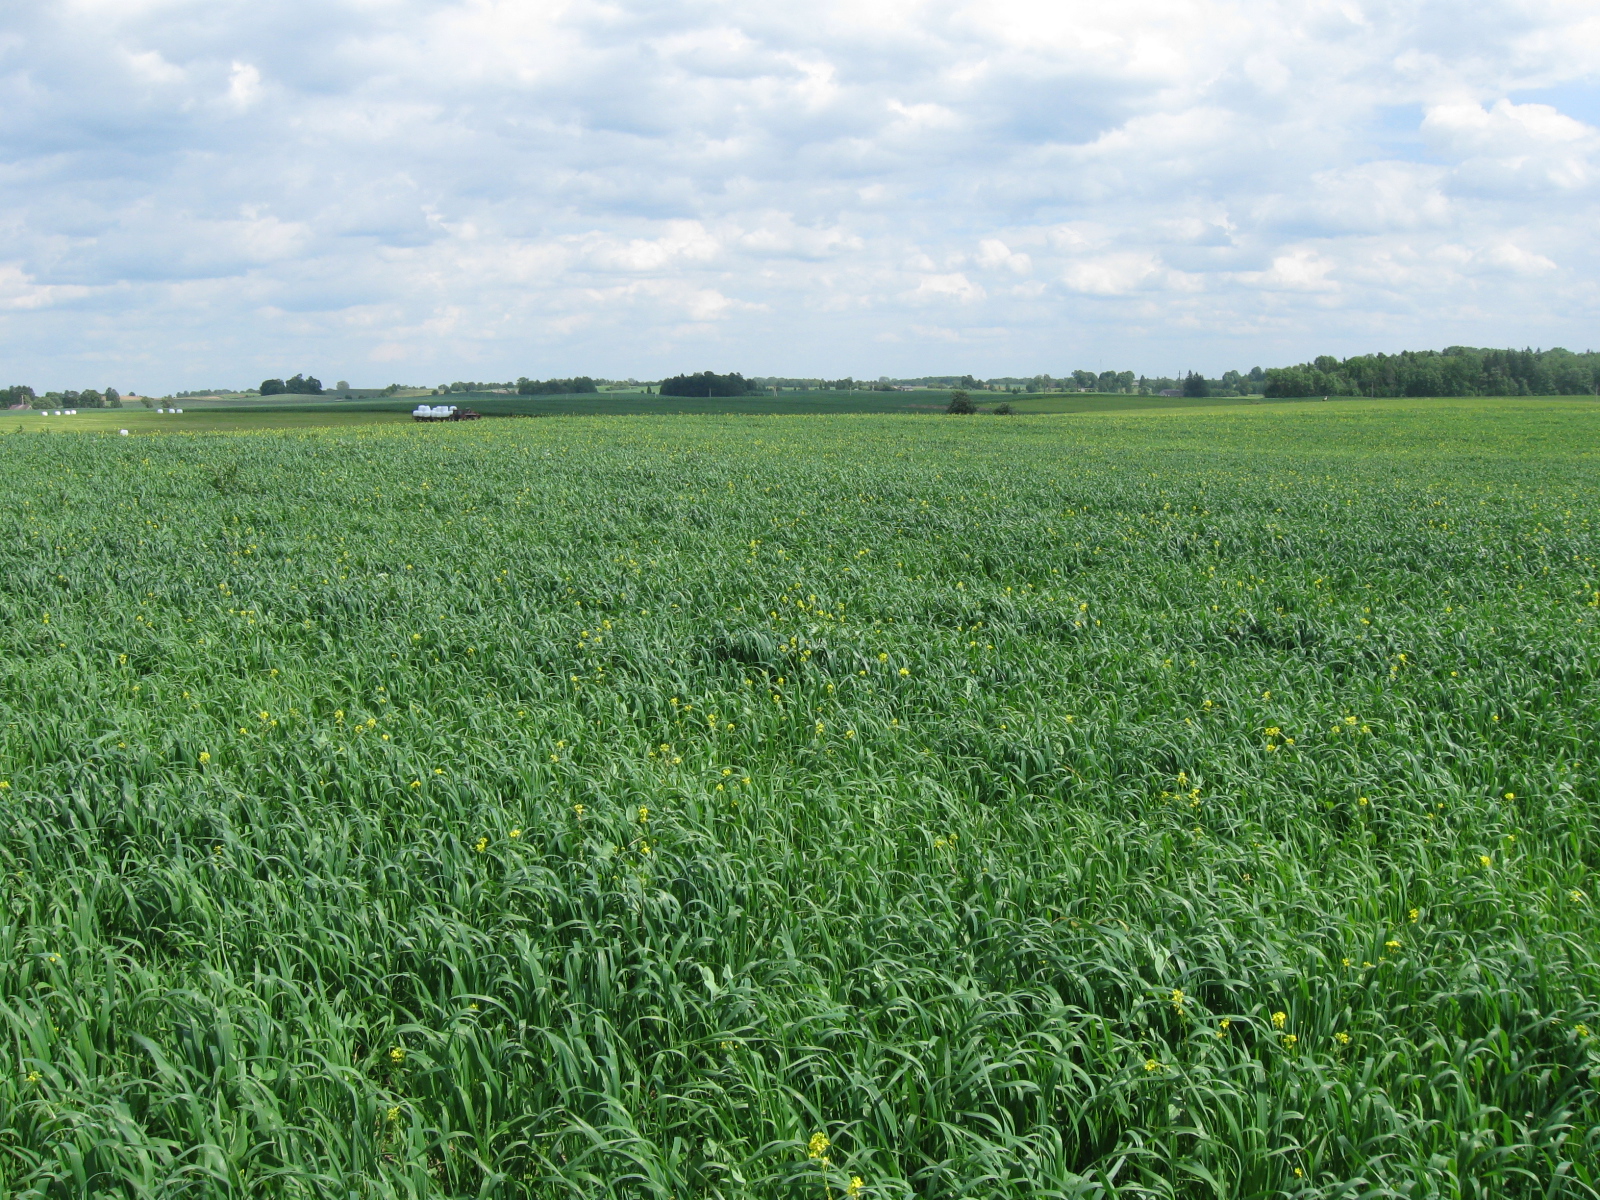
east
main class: Cropland
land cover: Oats
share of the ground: > 75 %
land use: Agriculture (excluding fallow land and kitchen gardens)
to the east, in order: Oats; Grassland without tree/shrub cover
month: June
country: LT
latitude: 54.3595
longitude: 23.7995
